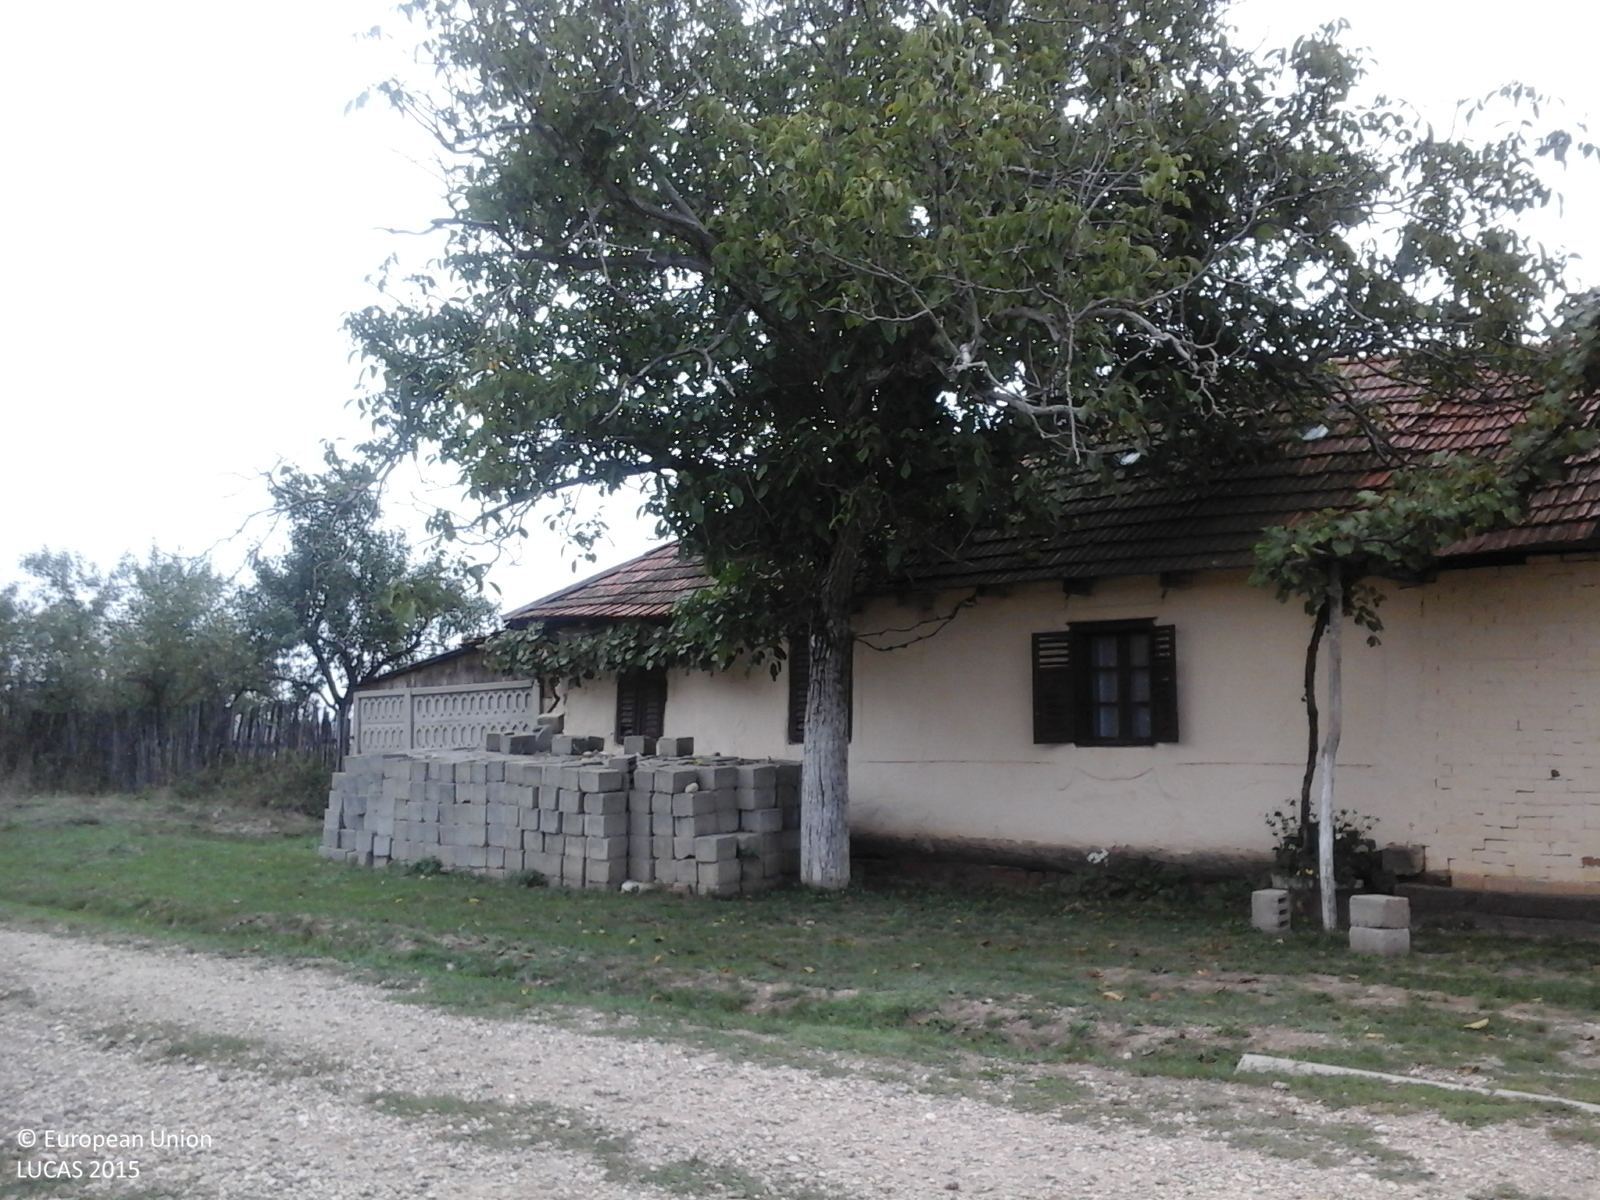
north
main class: Cropland
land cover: Apple fruit
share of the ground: > 75 %
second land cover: Grassland without tree/shrub cover
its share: > 75 %
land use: Agriculture (excluding fallow land and kitchen gardens)
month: September
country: RO
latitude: 45.6058
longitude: 21.9498
